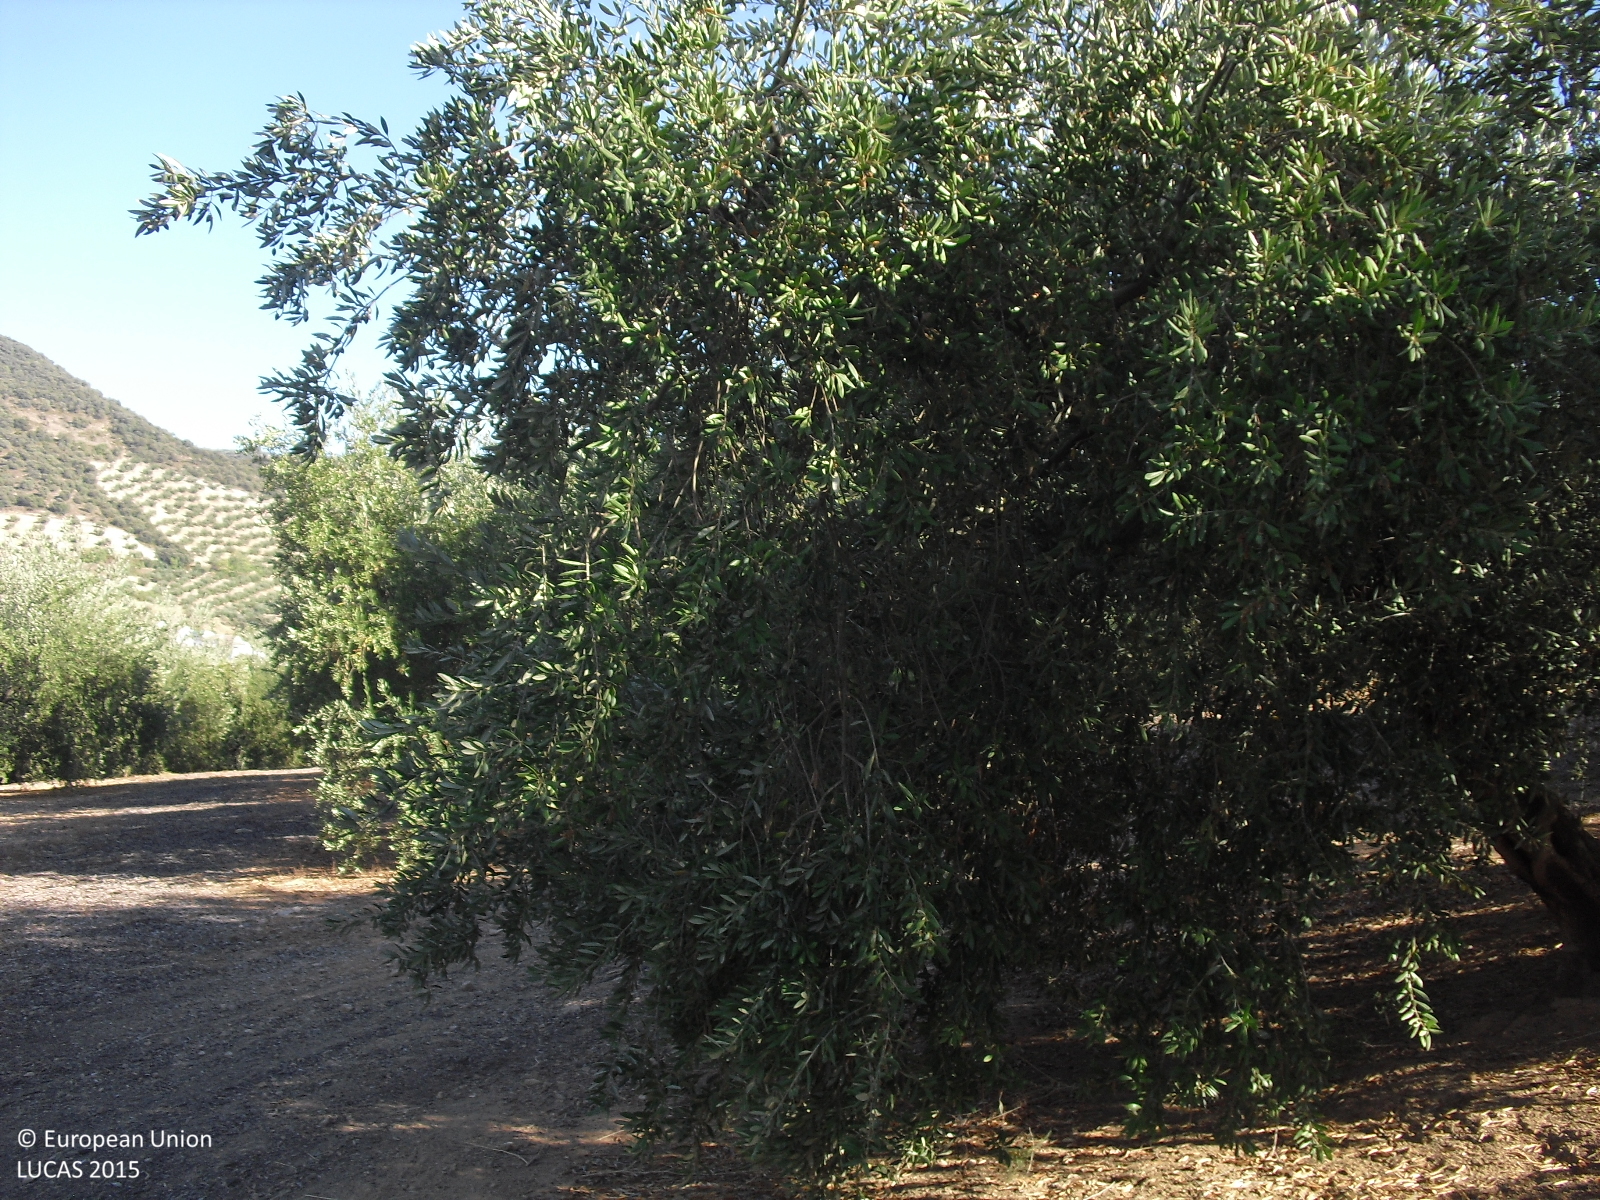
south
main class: Cropland
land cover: Olive groves
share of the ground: 25 - 50 %
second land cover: Other bare soil
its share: > 75 %
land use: Agriculture (excluding fallow land and kitchen gardens)
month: August
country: ES
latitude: 37.2897
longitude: -4.1531
